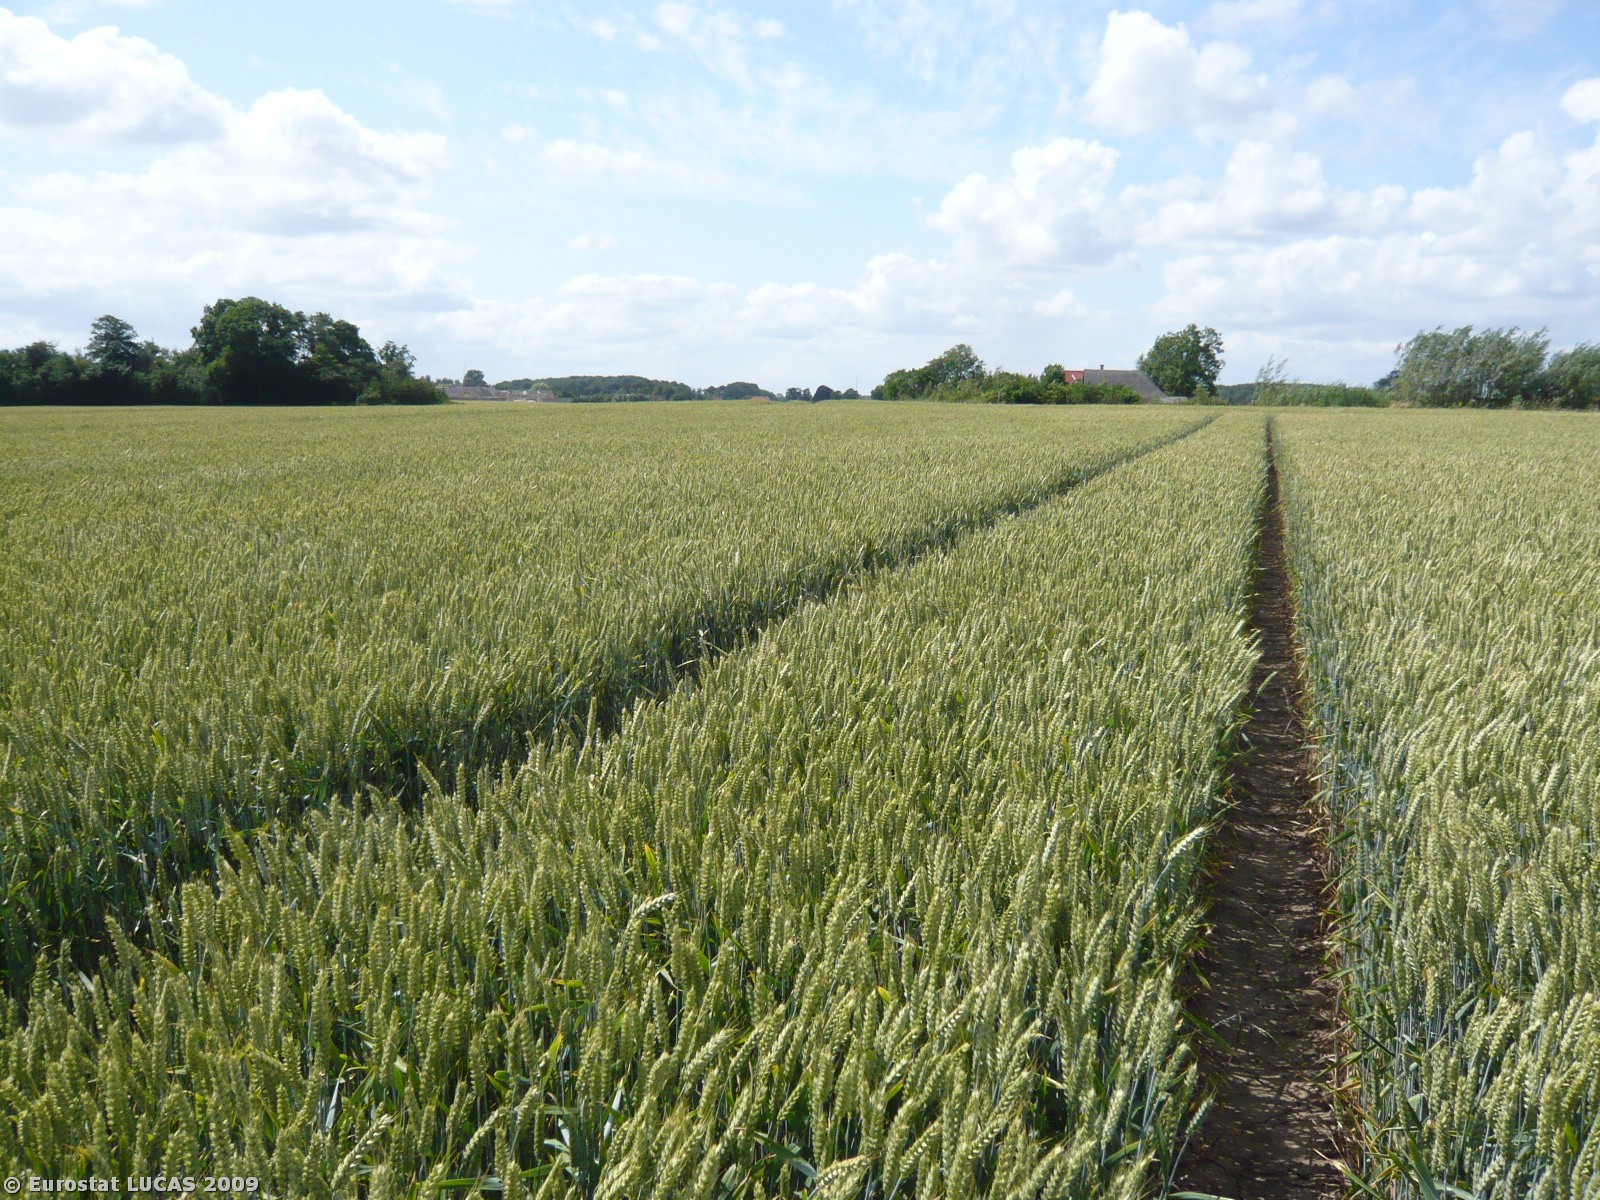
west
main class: Cropland
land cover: Common wheat
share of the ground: > 75 %
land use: Agriculture (excluding fallow land and kitchen gardens)
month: July
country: DK
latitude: 55.4132
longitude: 10.6470
